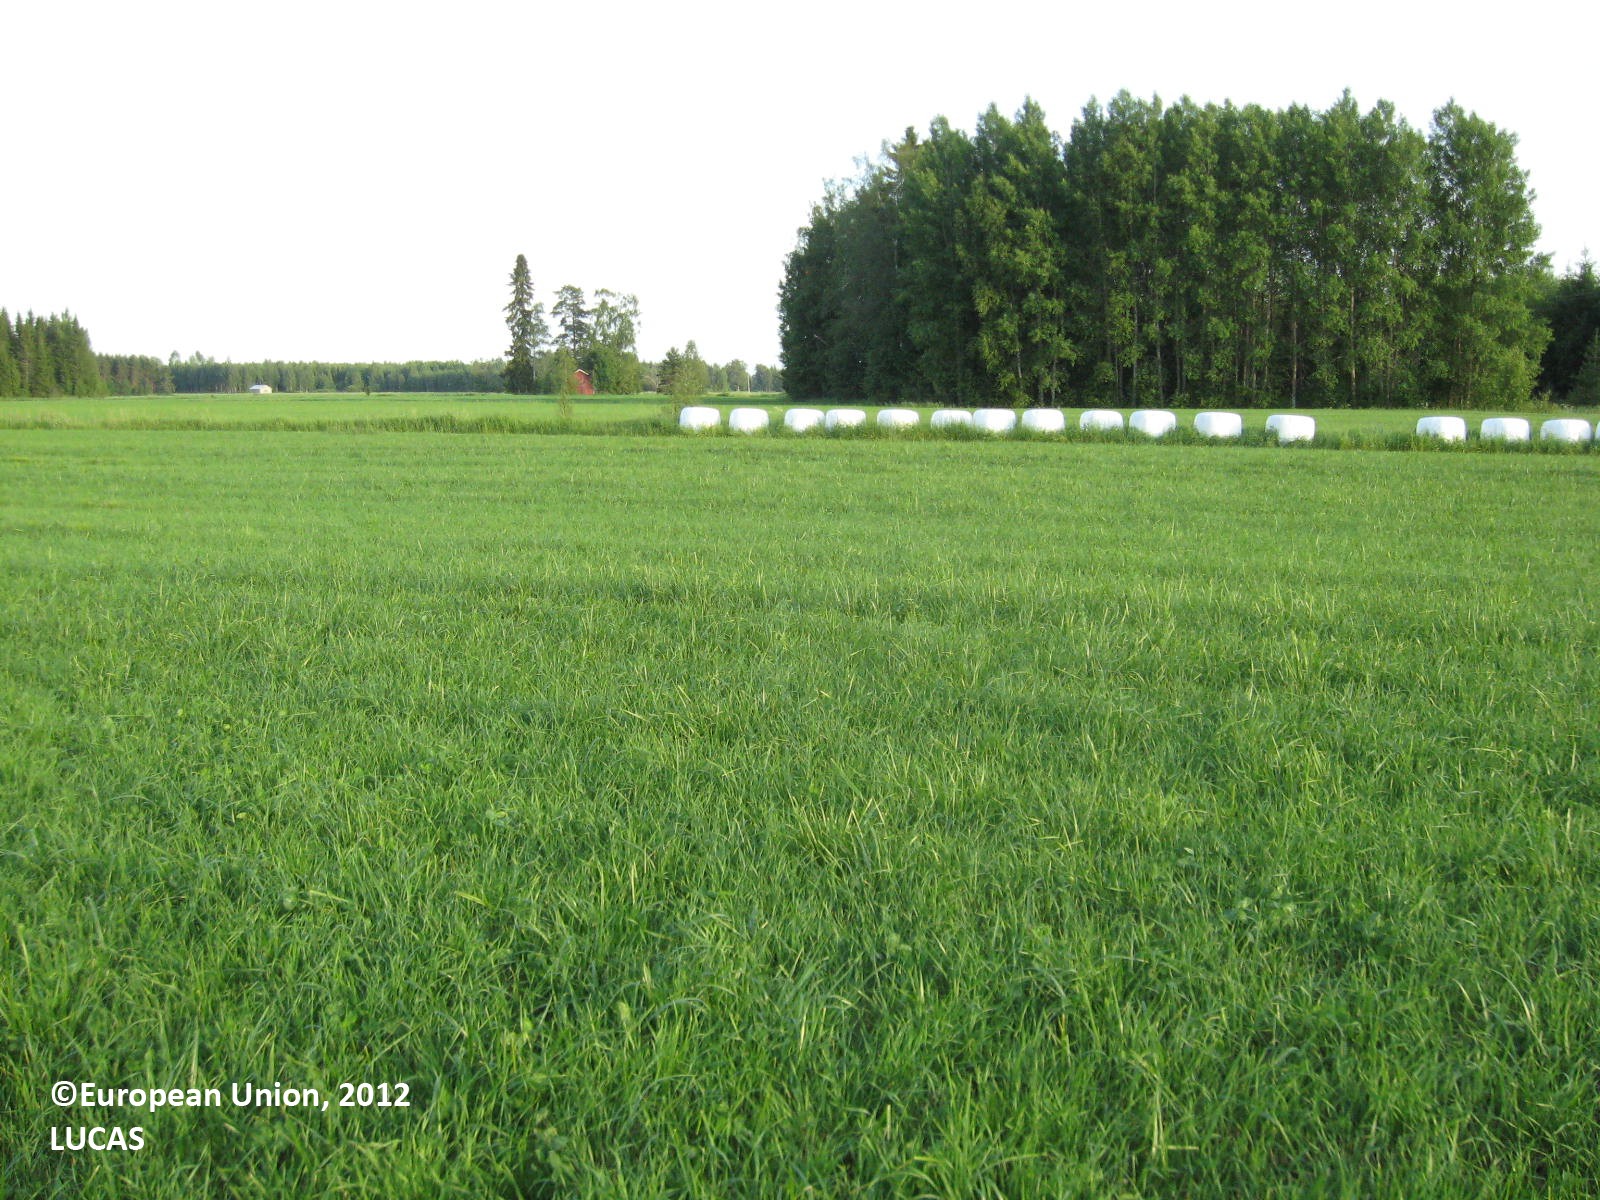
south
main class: Cropland
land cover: Temporary grasslands
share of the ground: > 75 %
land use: Agriculture (excluding fallow land and kitchen gardens)
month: July
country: FI
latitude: 62.5775
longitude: 21.6640
